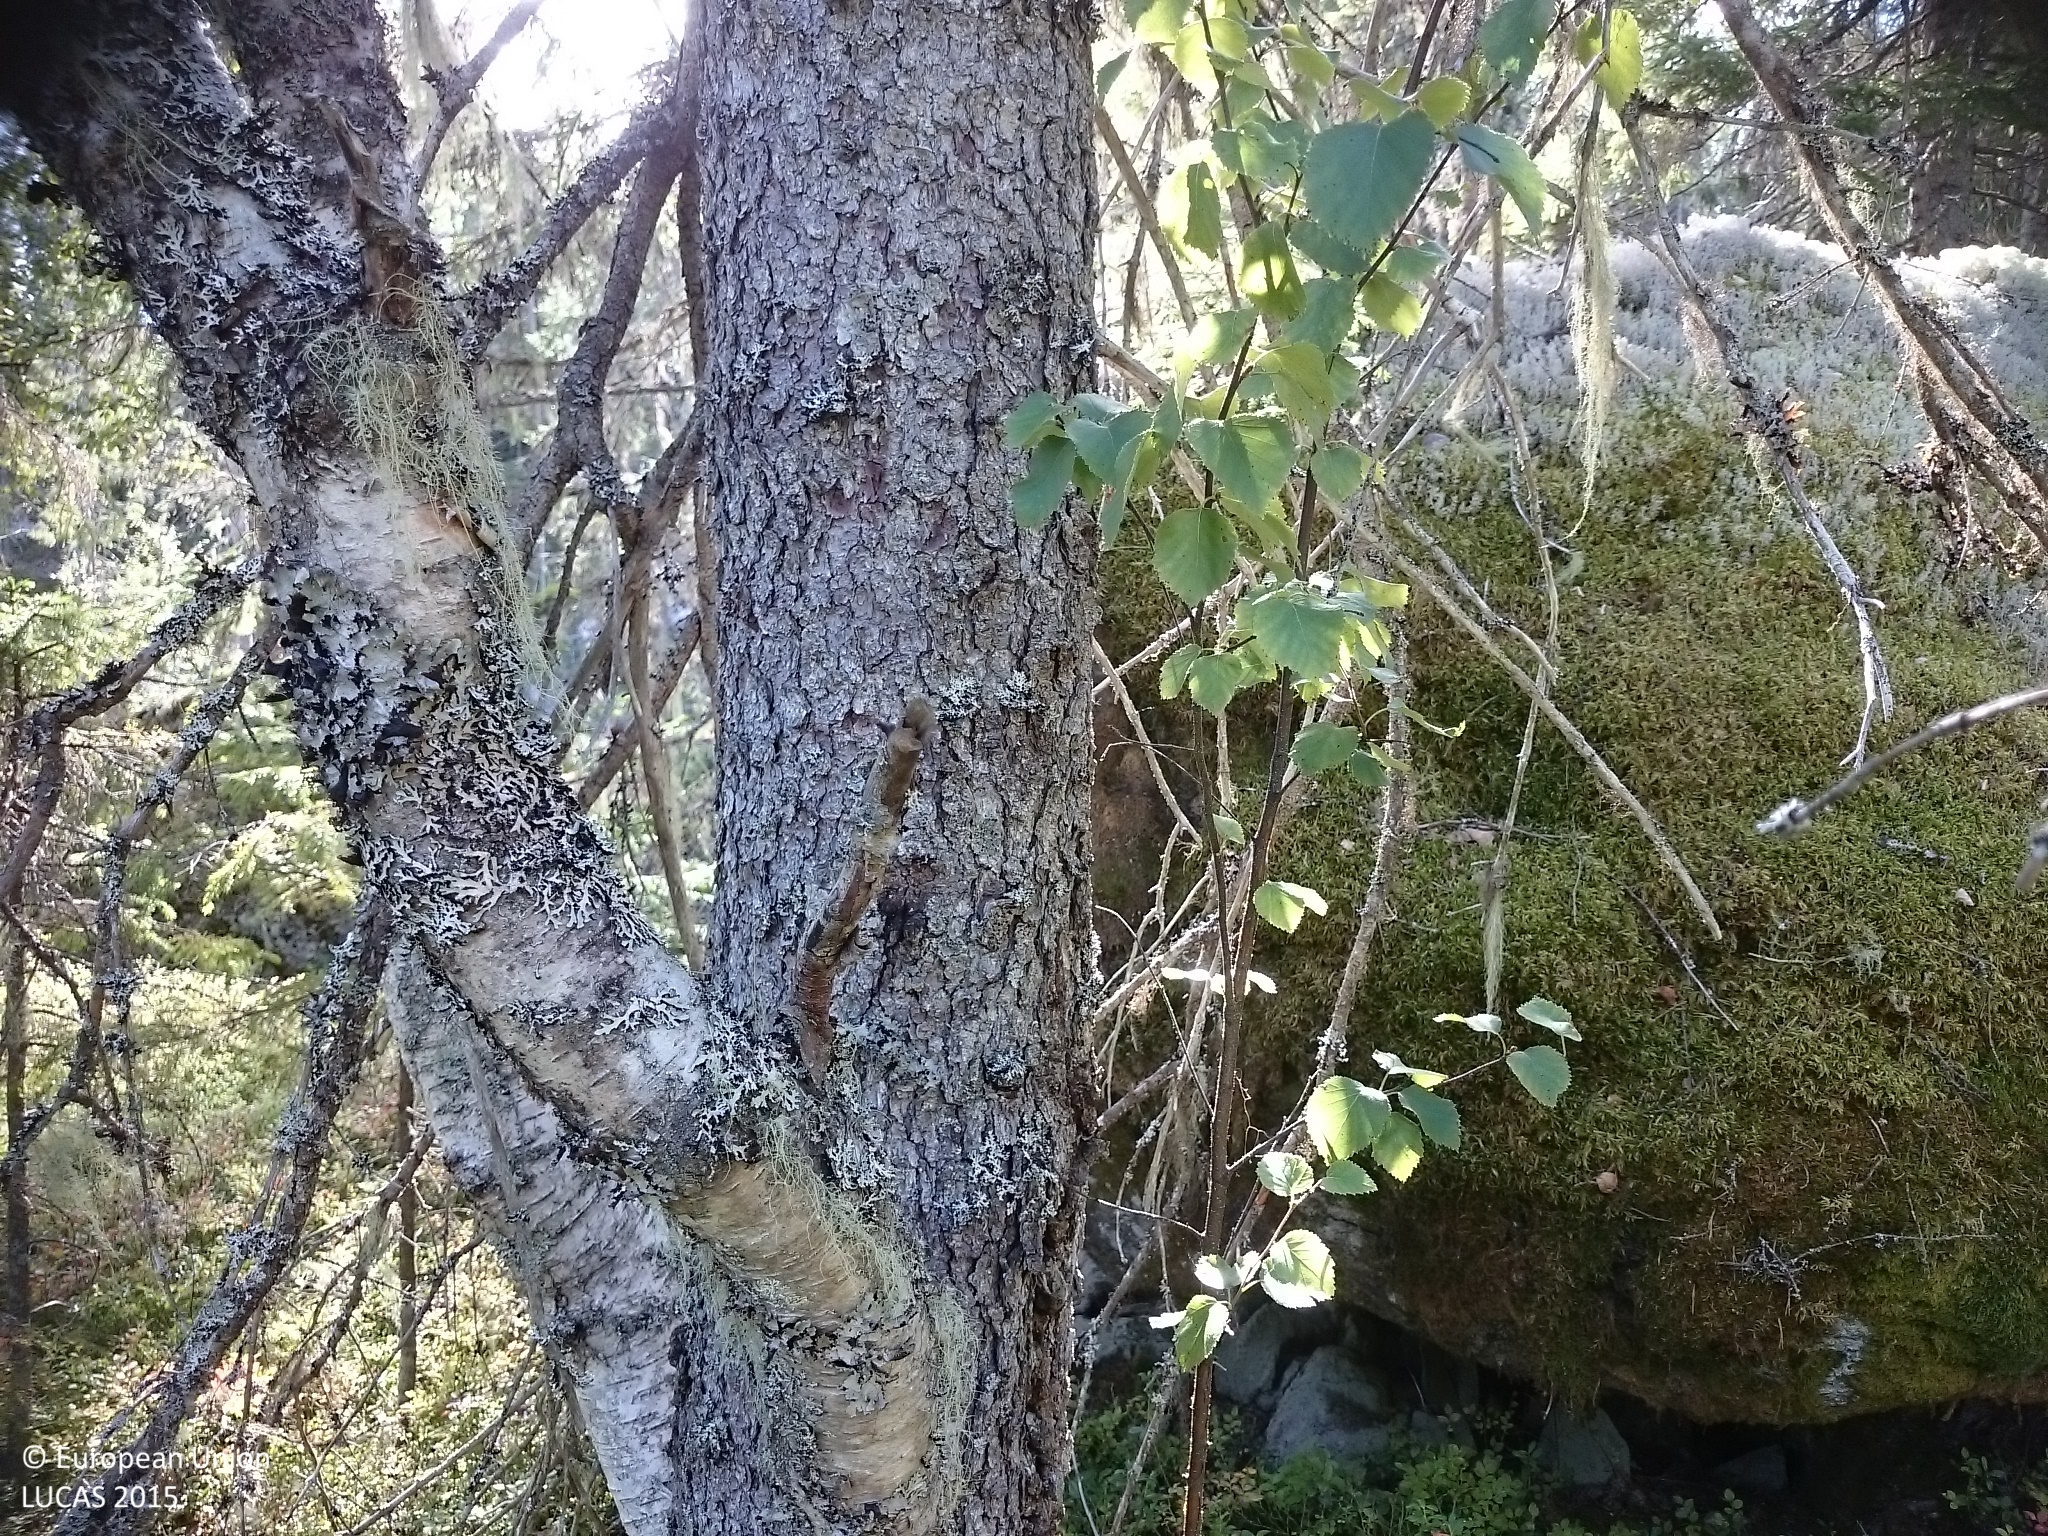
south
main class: Woodland
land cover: Spruce dominated coniferous woodland
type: boreal forest
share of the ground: 25 - 50 %
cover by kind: coniferous forest trees 50 %, shrubs 50 %
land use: Forestry
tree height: > 5 m
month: September
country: SE
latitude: 62.4184
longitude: 16.8912
